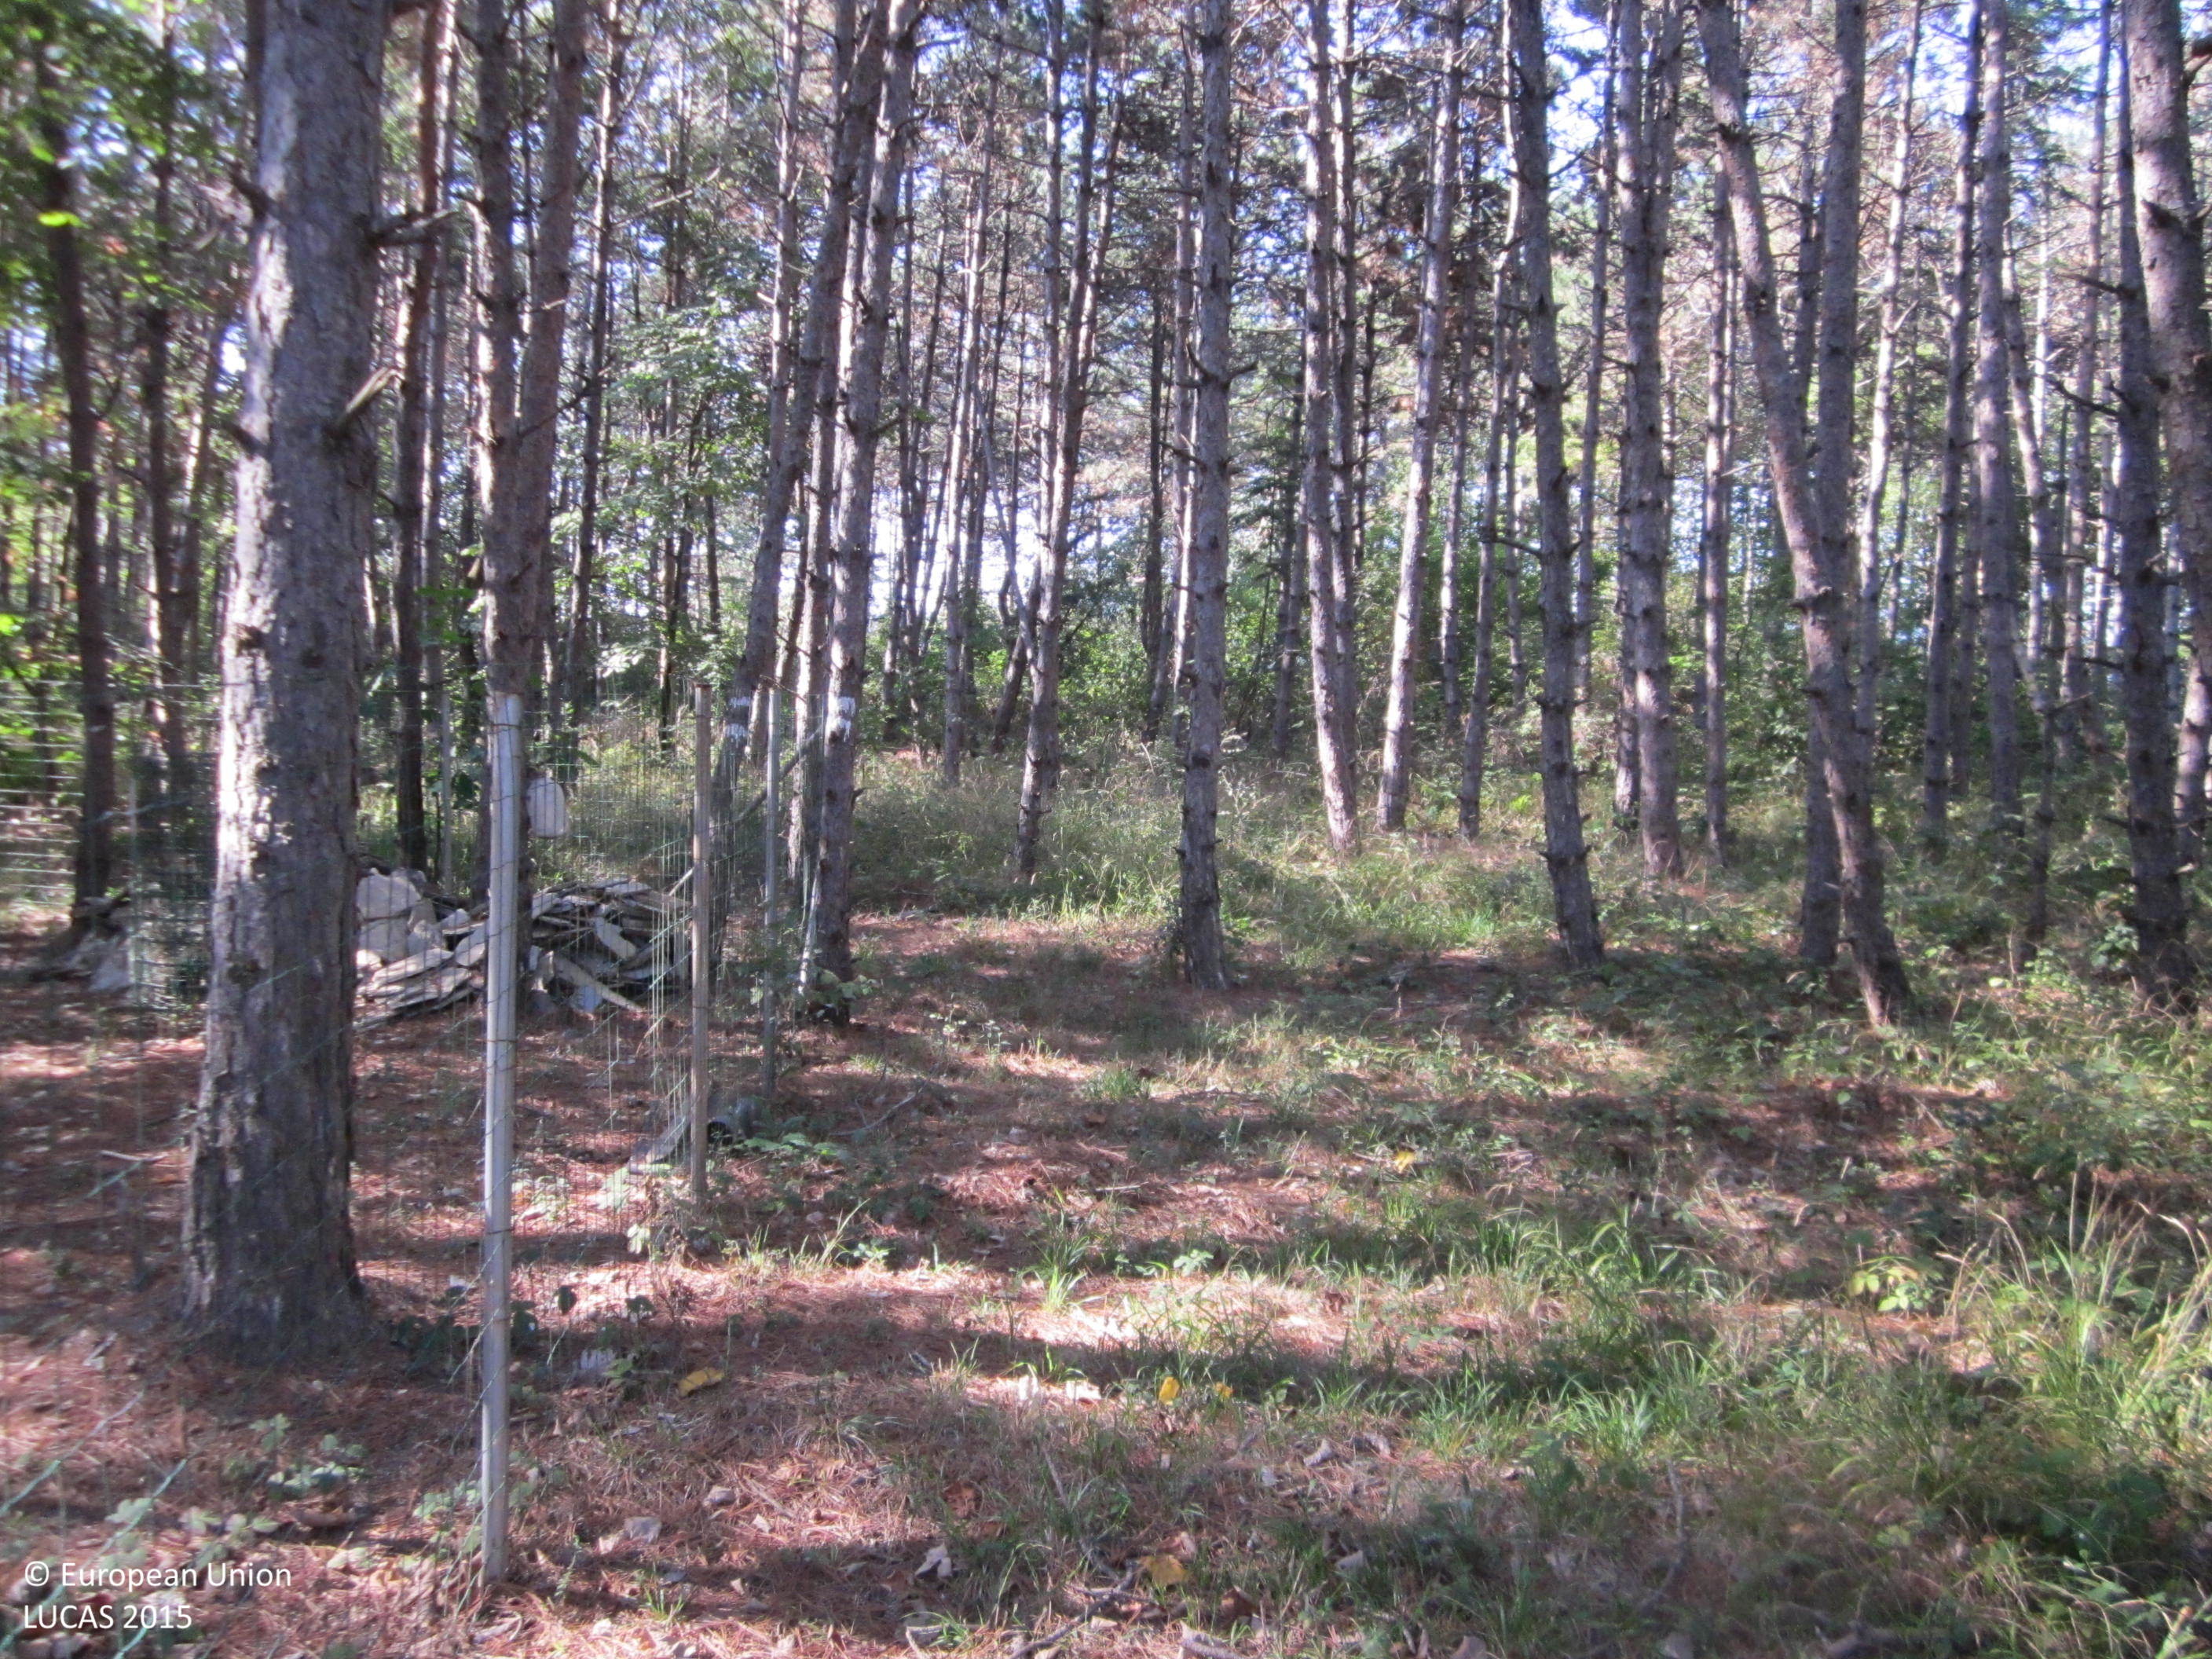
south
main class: Woodland
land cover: Pine dominated mixed woodland
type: acidophilous oak and oak-birch forest
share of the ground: > 75 %
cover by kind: coniferous forest trees 60 %, broadleaved forest trees 20 %, unconsolidated bare surface 20 %
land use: Forestry
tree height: > 5 m
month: September
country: BG
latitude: 42.1813
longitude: 27.8354
